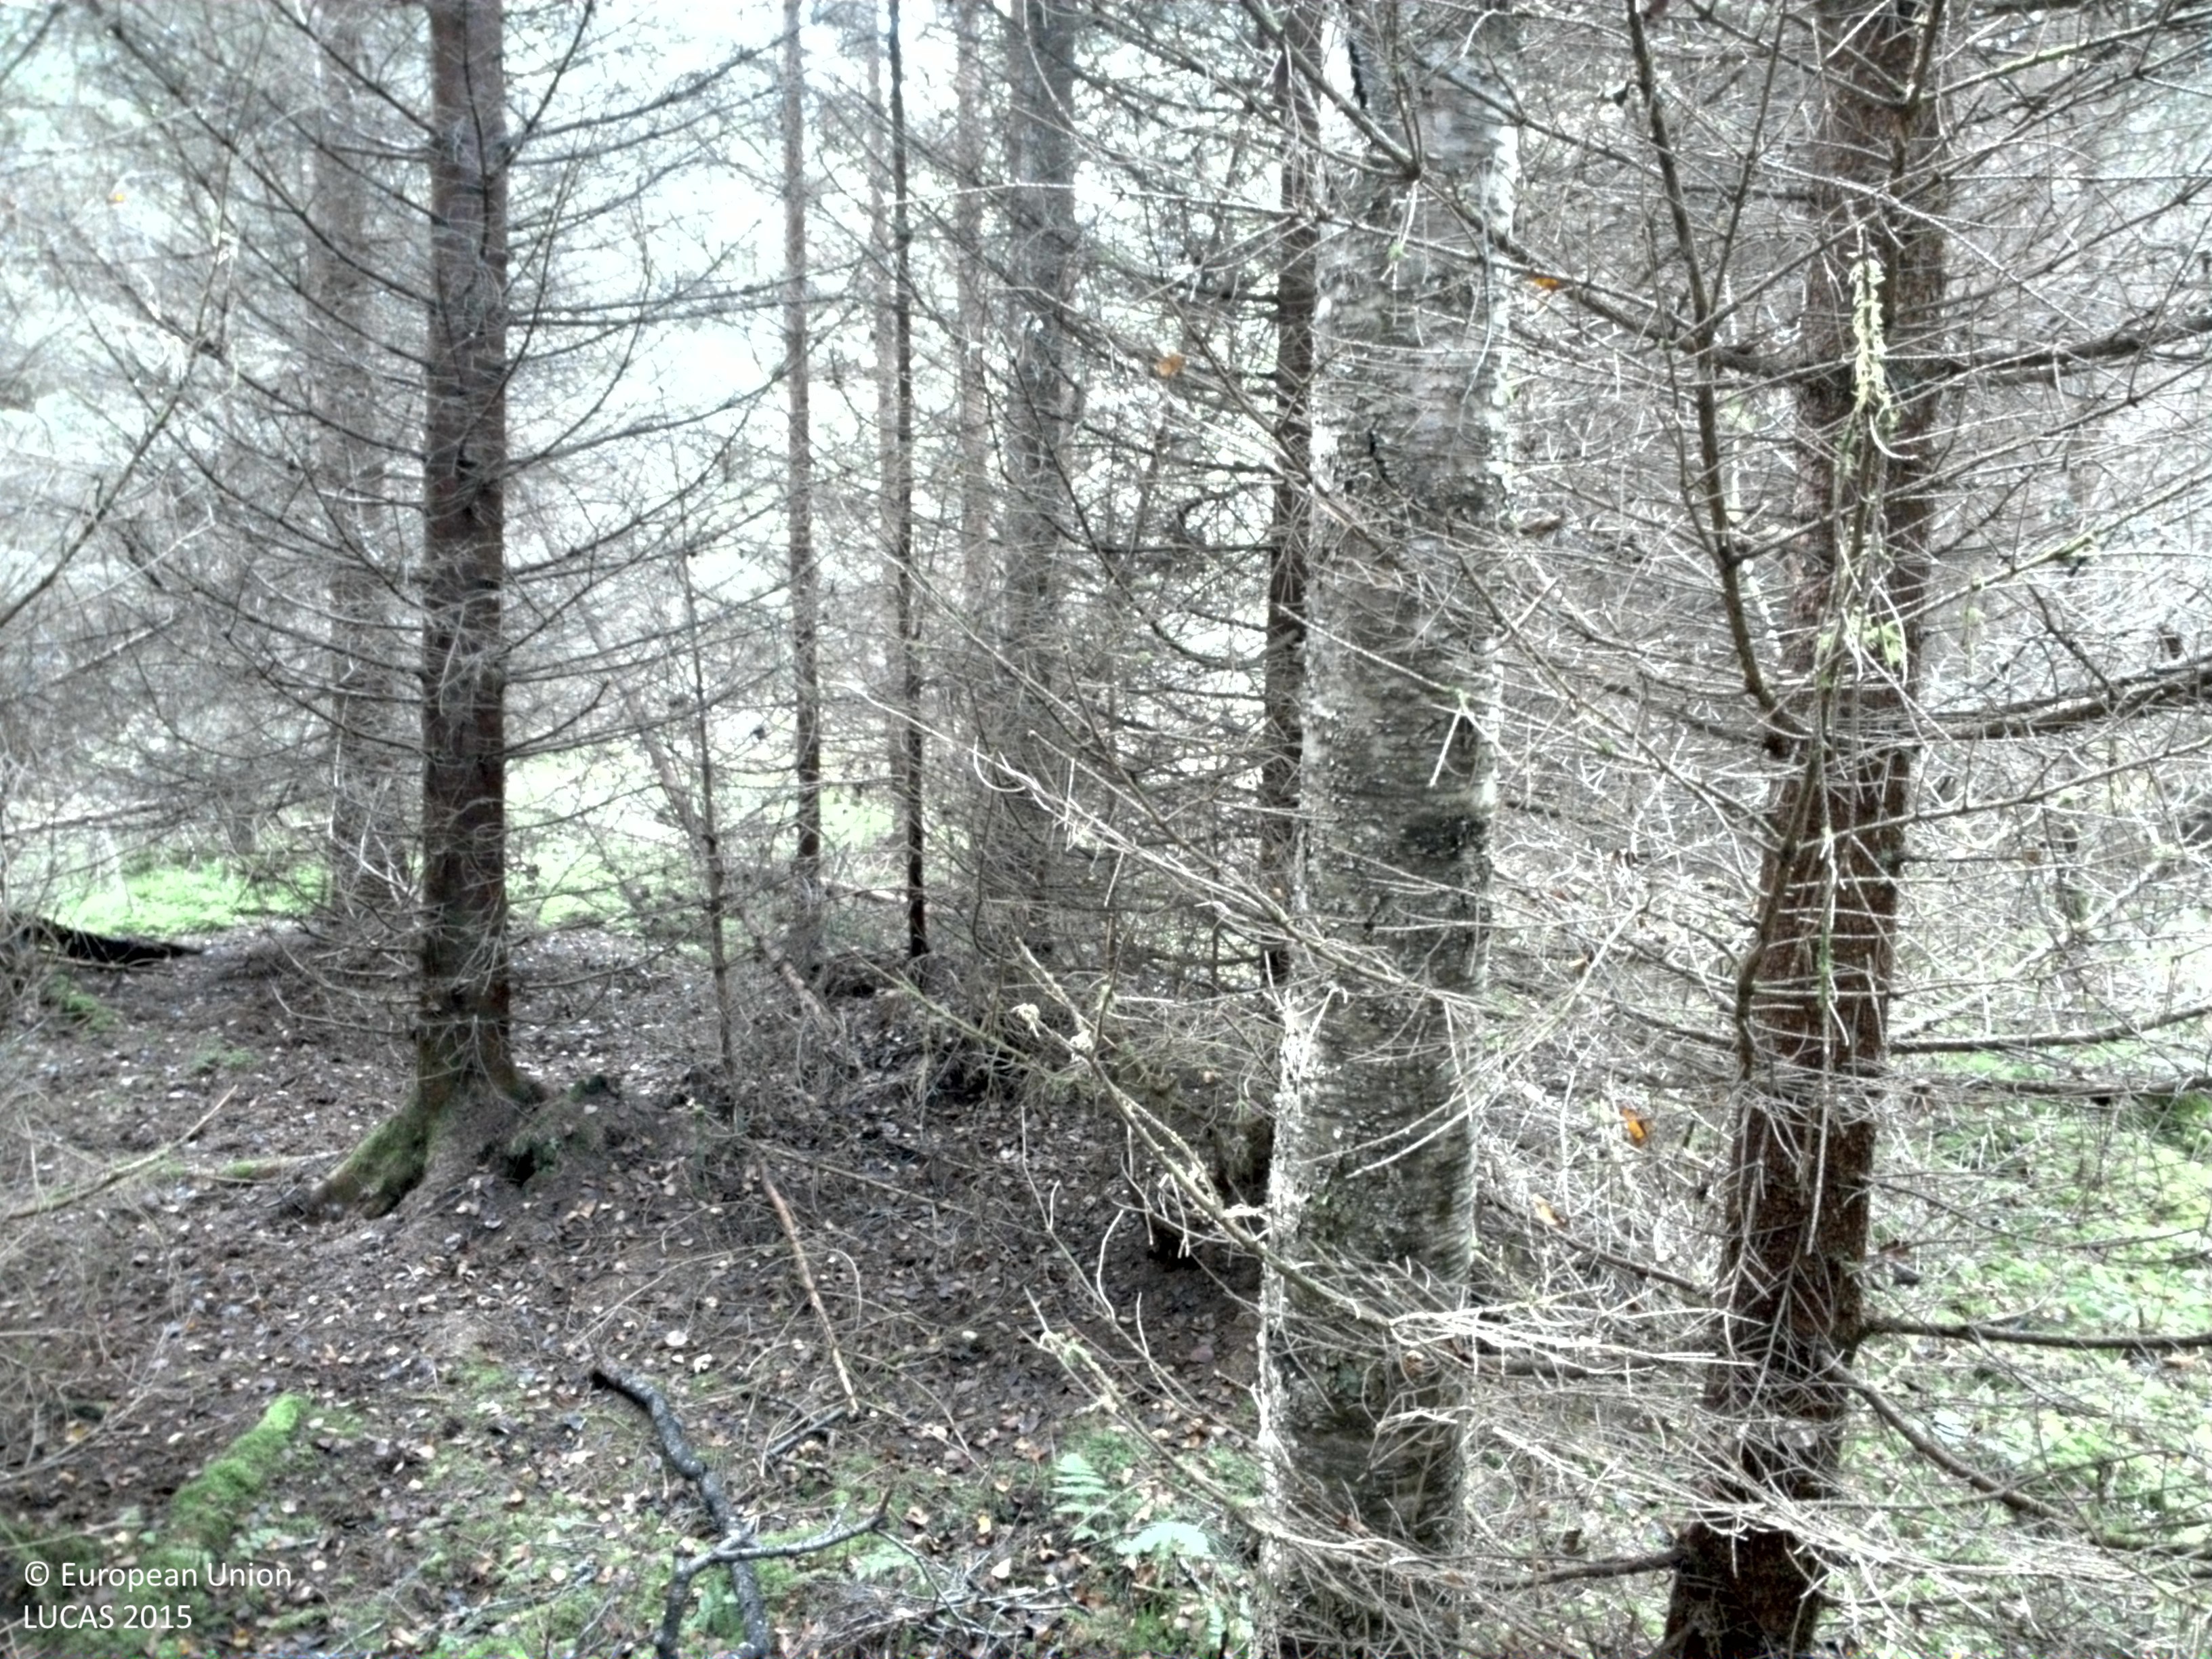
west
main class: Woodland
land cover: Spruce dominated coniferous woodland
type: boreal forest
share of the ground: 50 - 75 %
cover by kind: coniferous forest trees 60 %, lichens and mosses 35 %, broadleaved forest trees 5 %
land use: Forestry
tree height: > 5 m
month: September
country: SE
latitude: 59.1288
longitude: 14.1331
